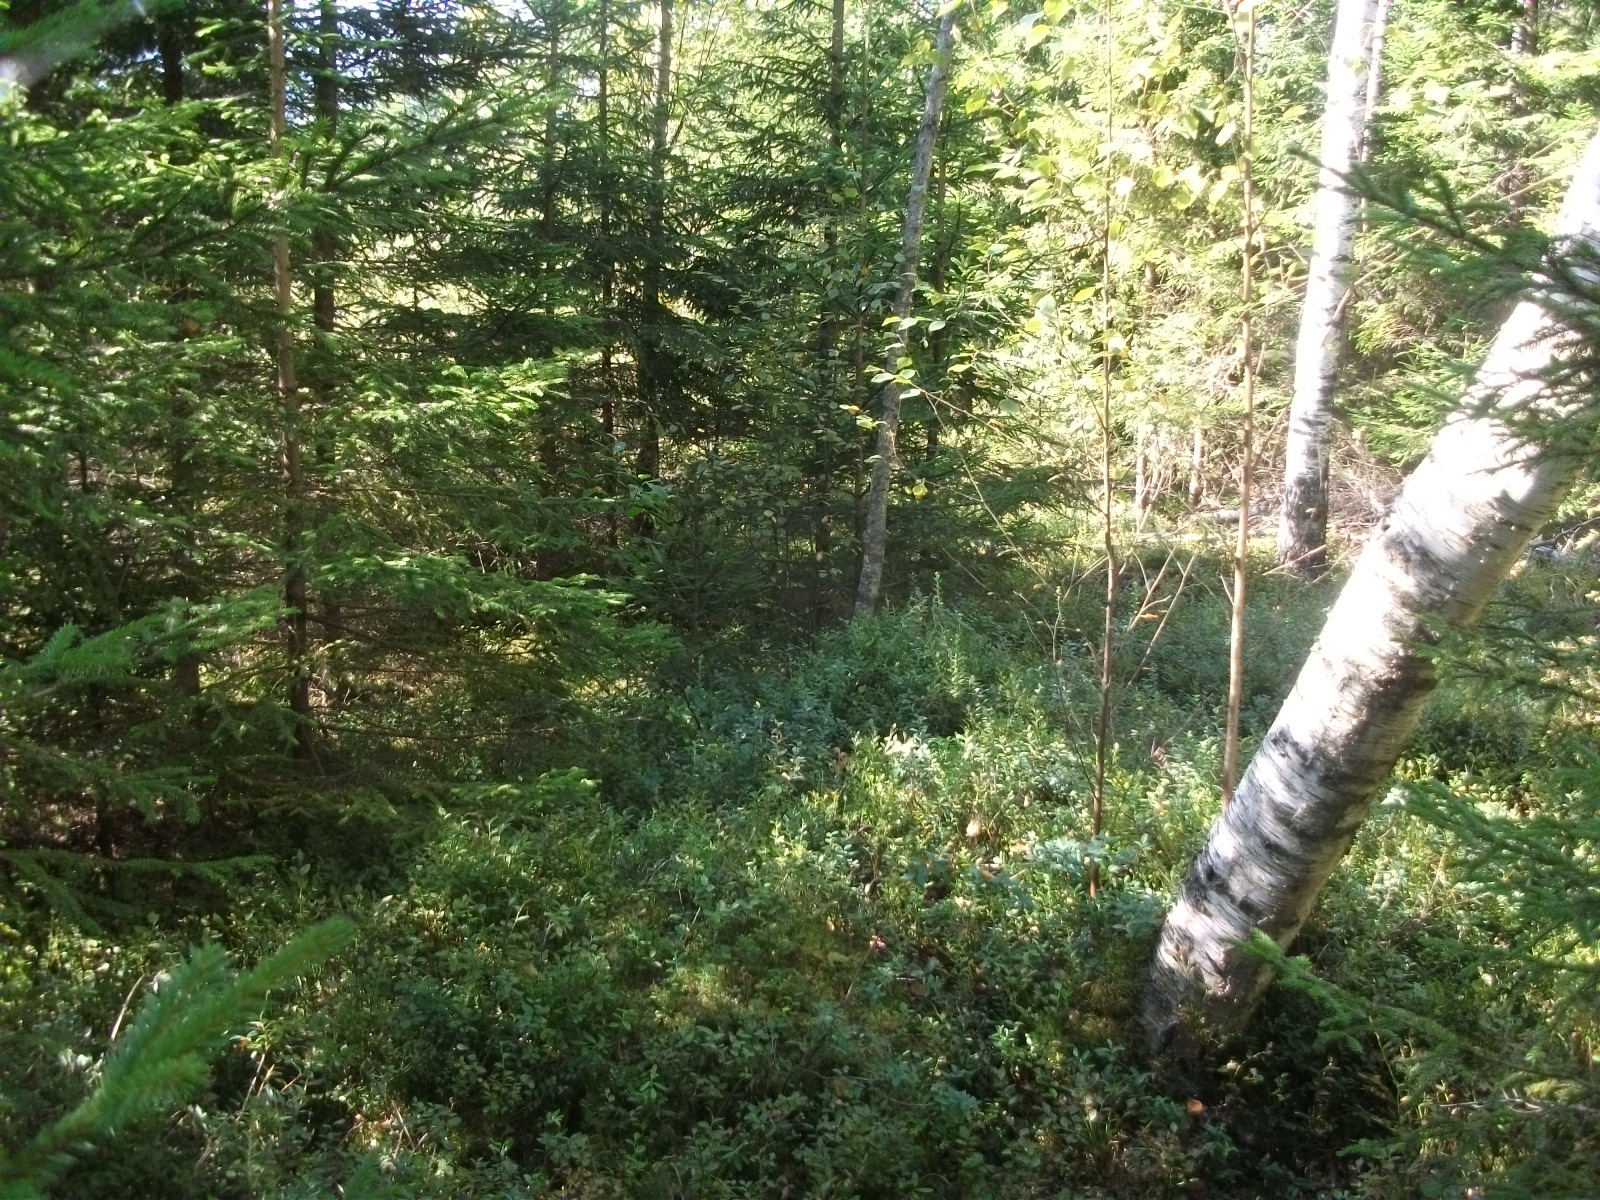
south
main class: Woodland
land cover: Spruce dominated mixed woodland
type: hemiboreal forest and nemoral coniferous forest and mixed broadleaved-coniferous forest
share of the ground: > 75 %
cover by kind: coniferous forest trees 55 %, broadleaved forest trees 25 %, herbaceous plants 15 %, shrubs 5 %
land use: Forestry
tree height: > 5 m
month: August
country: LV
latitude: 56.4338
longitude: 26.2109
